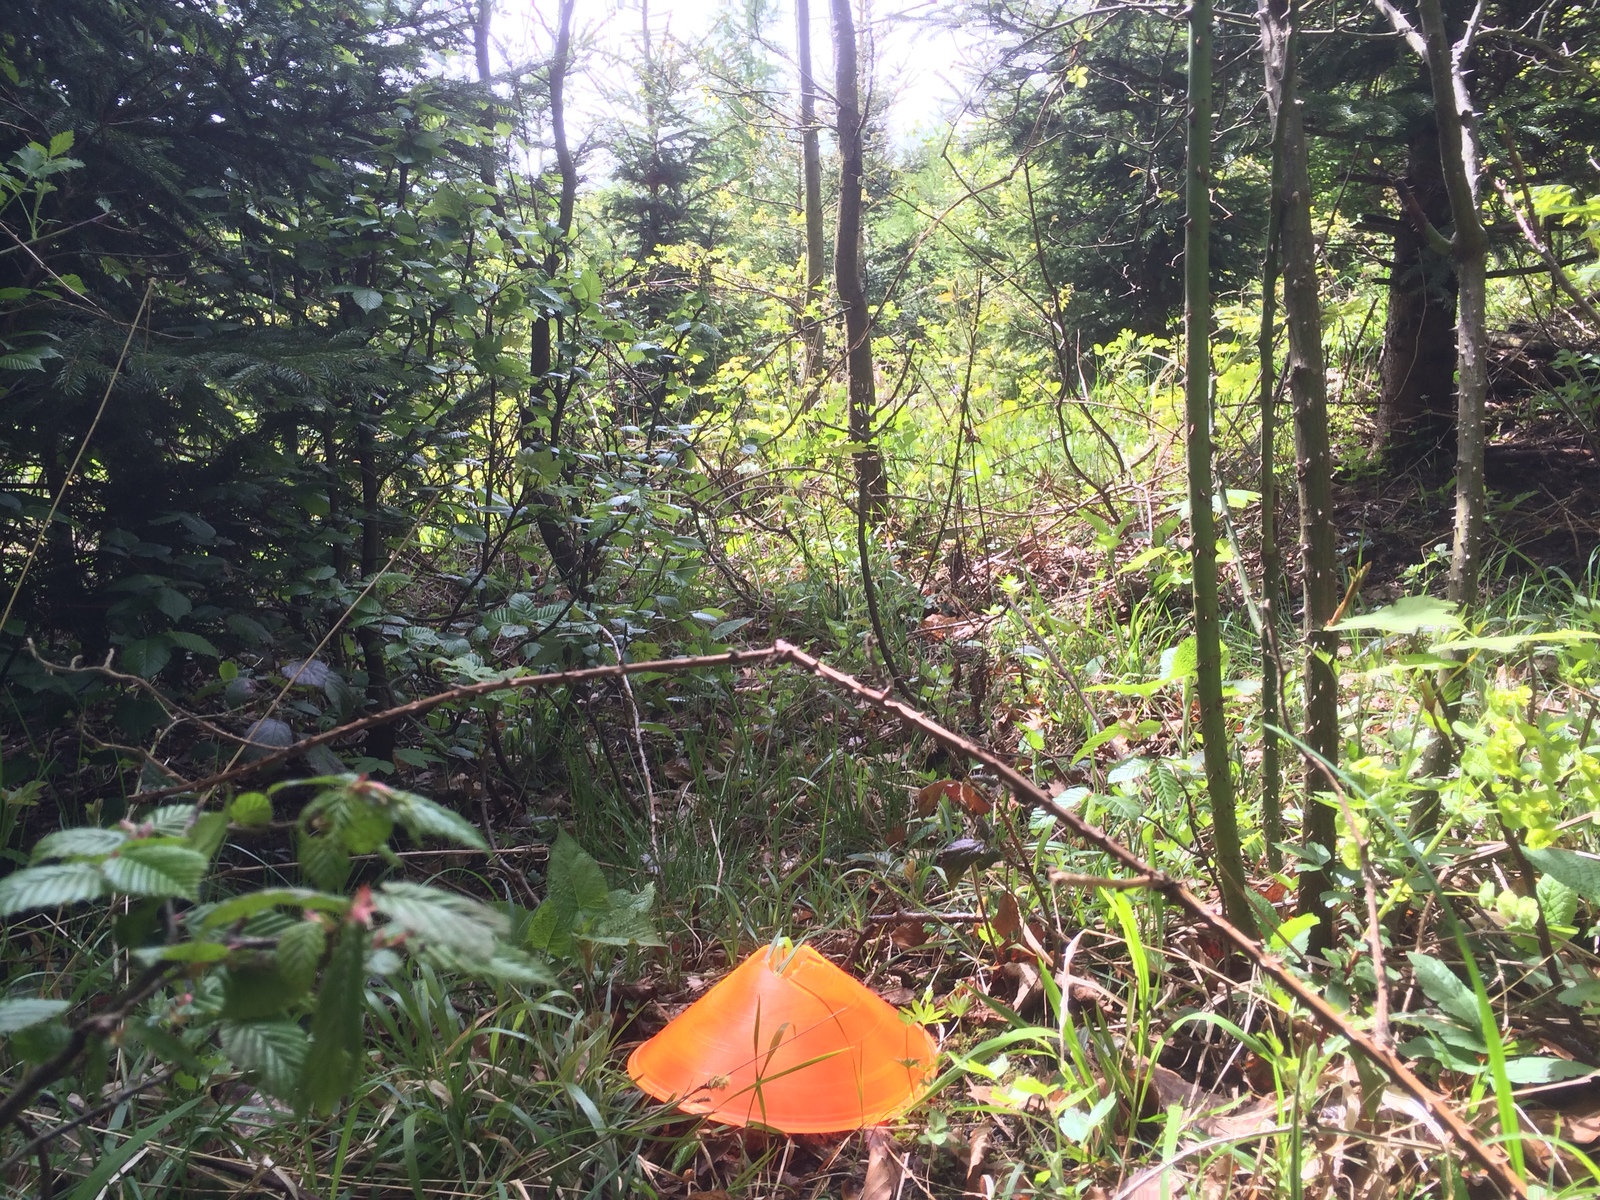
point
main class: Woodland
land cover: Spruce dominated mixed woodland
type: alpine coniferous forest
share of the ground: > 75 %
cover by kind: coniferous forest trees 45 %, broadleaved forest trees 45 %, herbaceous plants 10 %
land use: Forestry
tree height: > 5 m
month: May
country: AT
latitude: 48.0915
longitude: 16.0859
